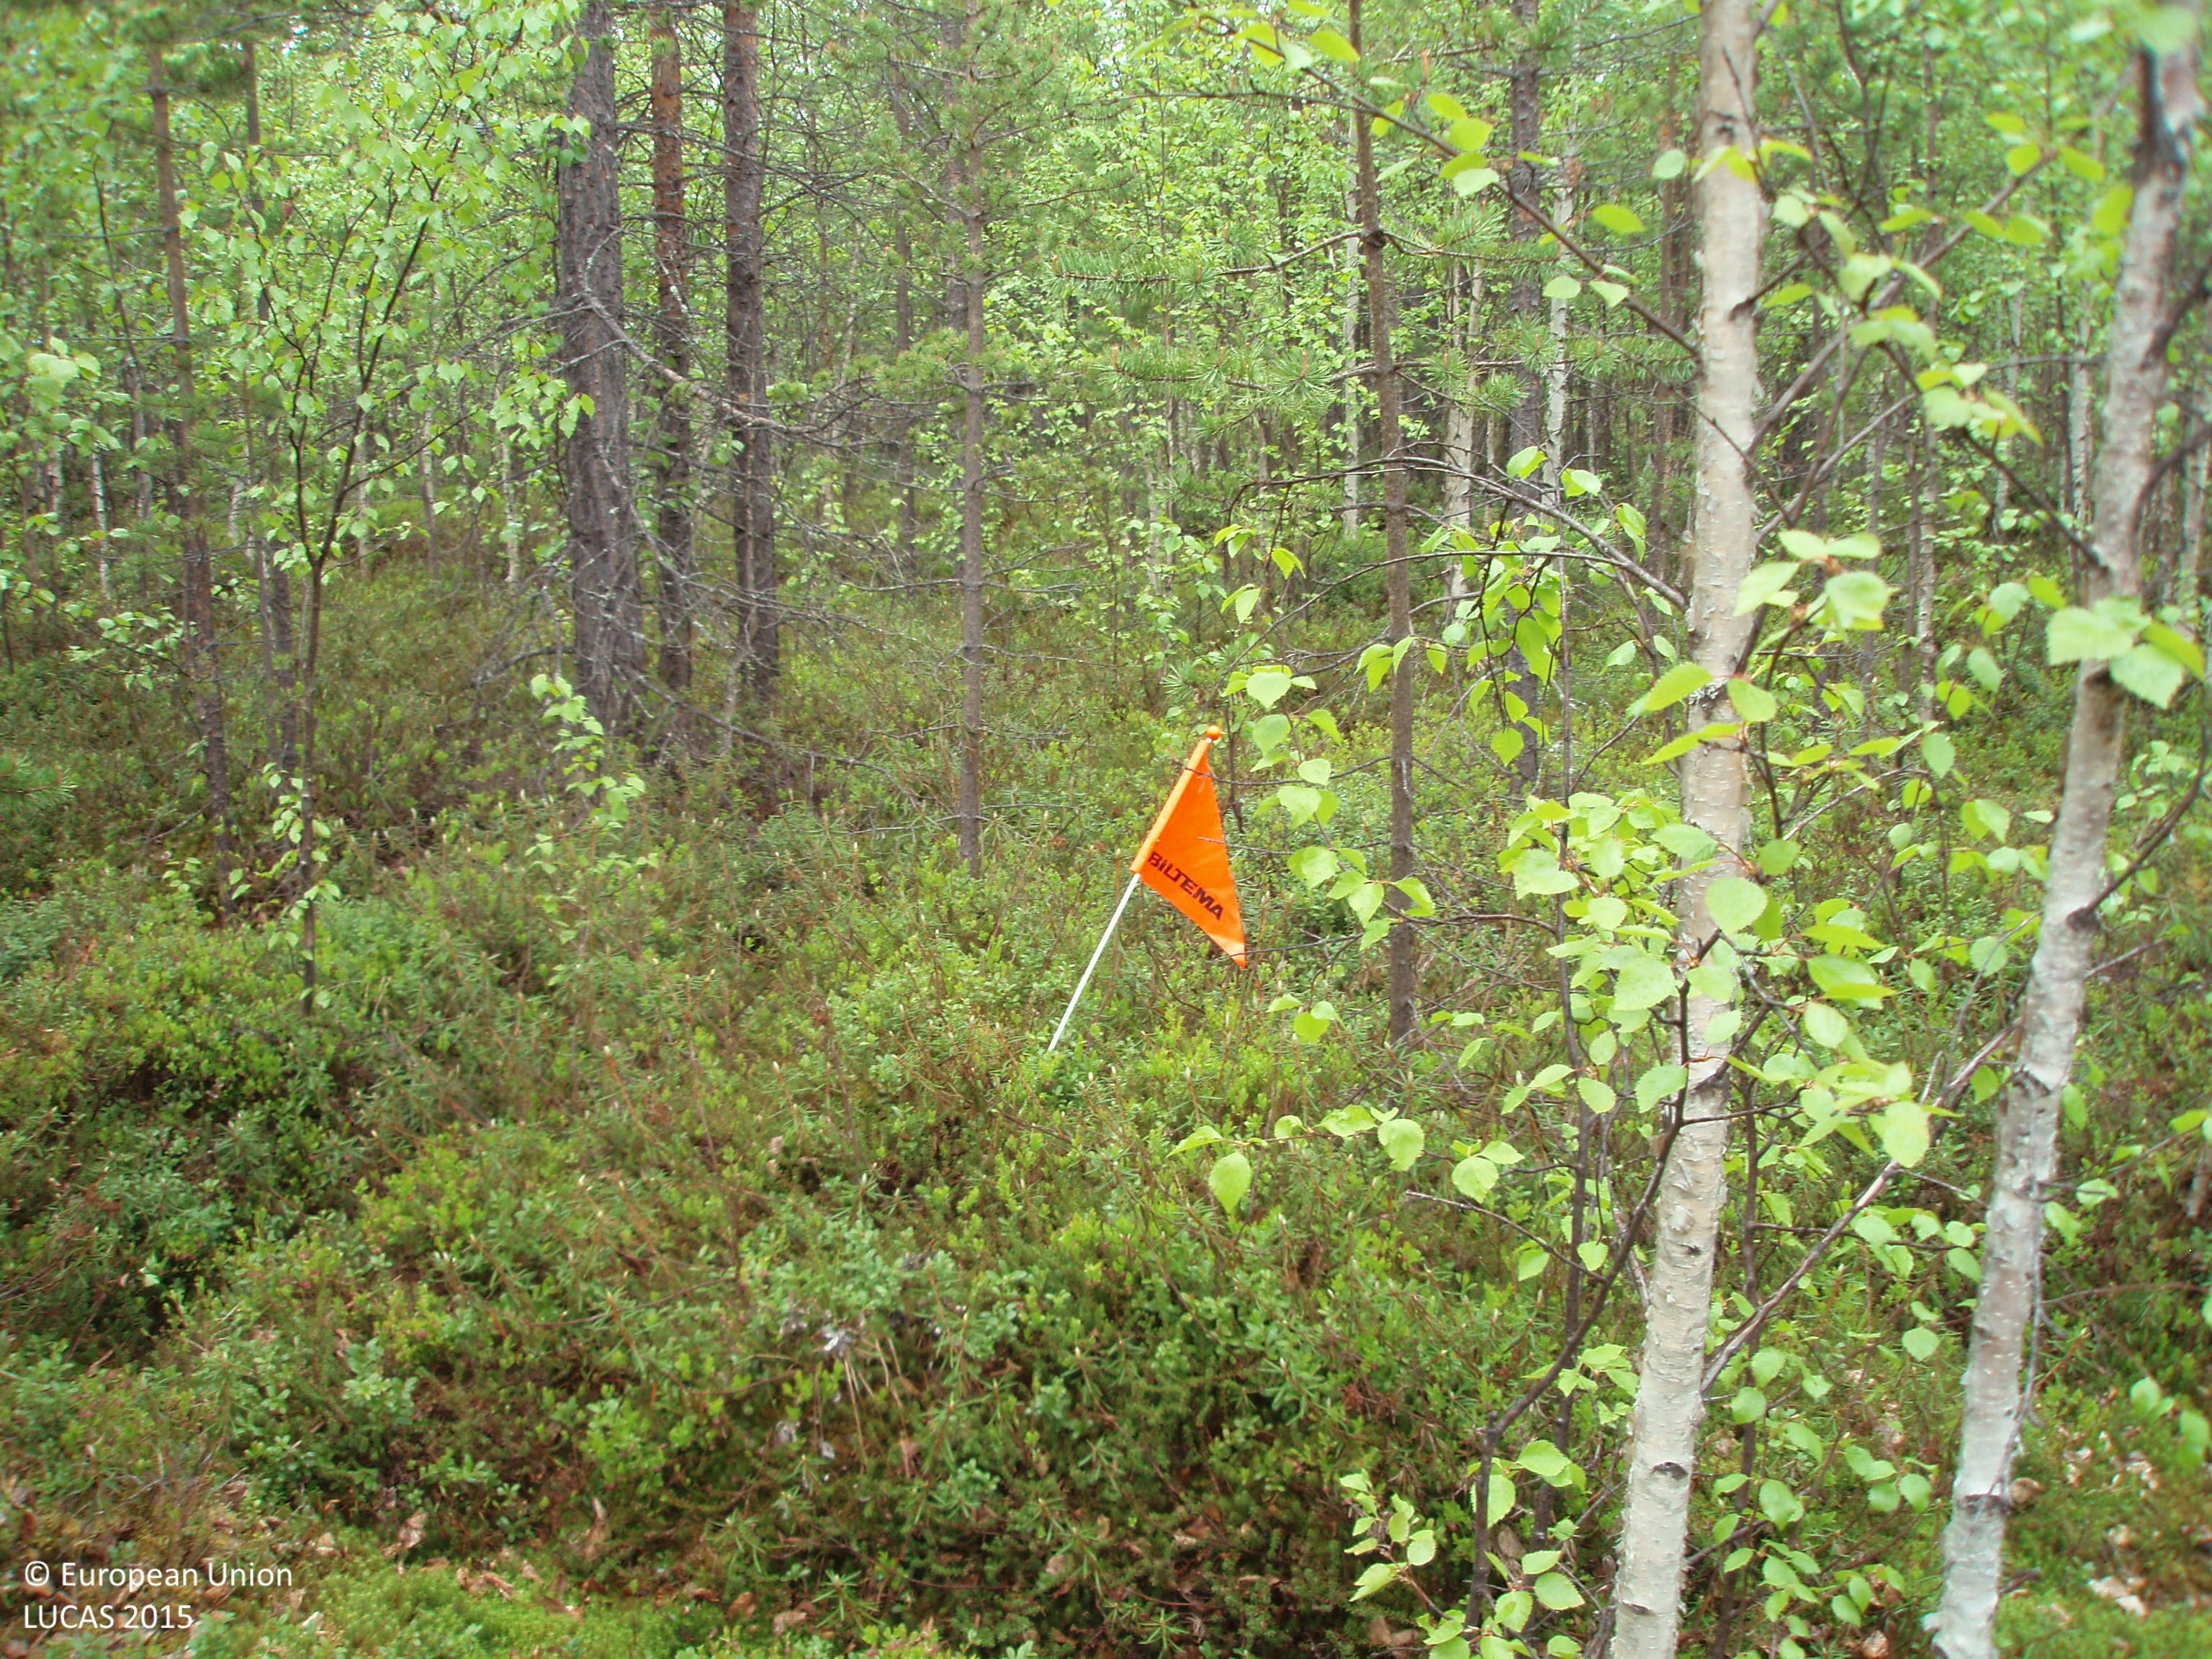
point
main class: Woodland
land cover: Pine dominated mixed woodland
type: boreal forest
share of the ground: > 75 %
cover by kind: broadleaved forest trees 70 %, coniferous forest trees 25 %, shrubs 5 %
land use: Forestry
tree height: > 5 m
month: June
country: FI
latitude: 67.3903
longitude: 26.6972
